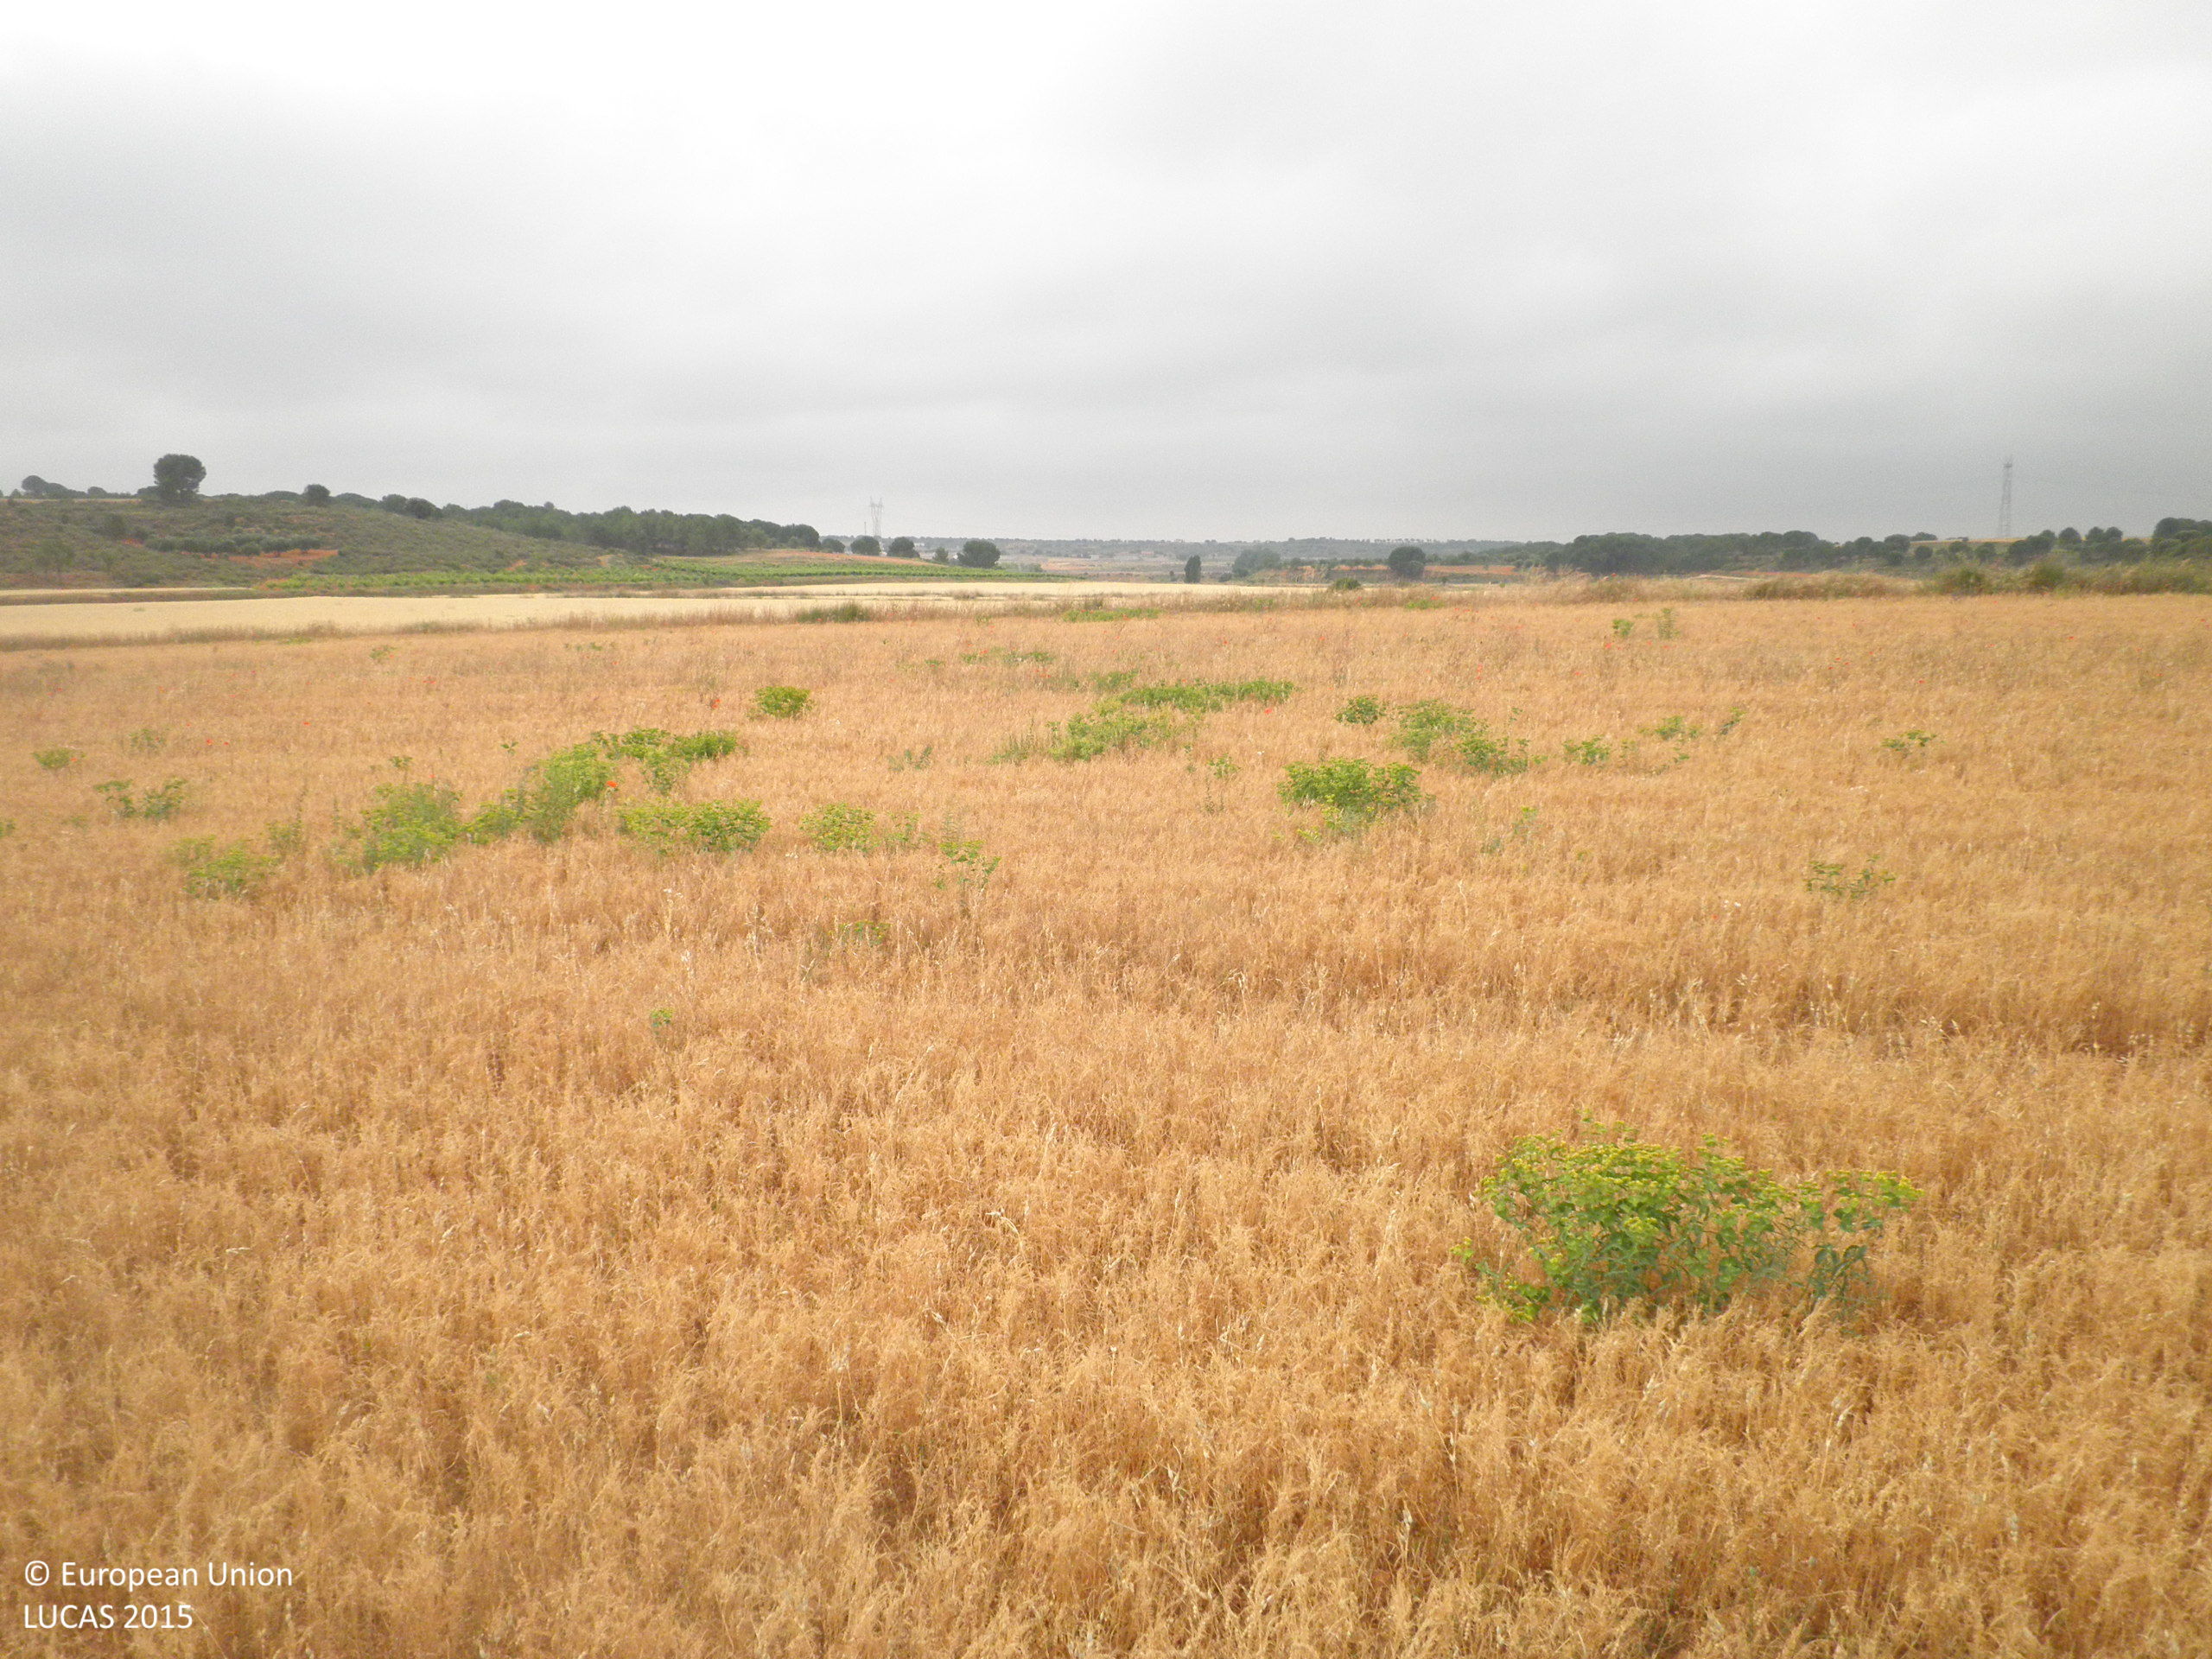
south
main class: Cropland
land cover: Dry pulses
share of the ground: > 75 %
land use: Agriculture (excluding fallow land and kitchen gardens)
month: June
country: ES
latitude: 39.5380
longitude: -1.7697
